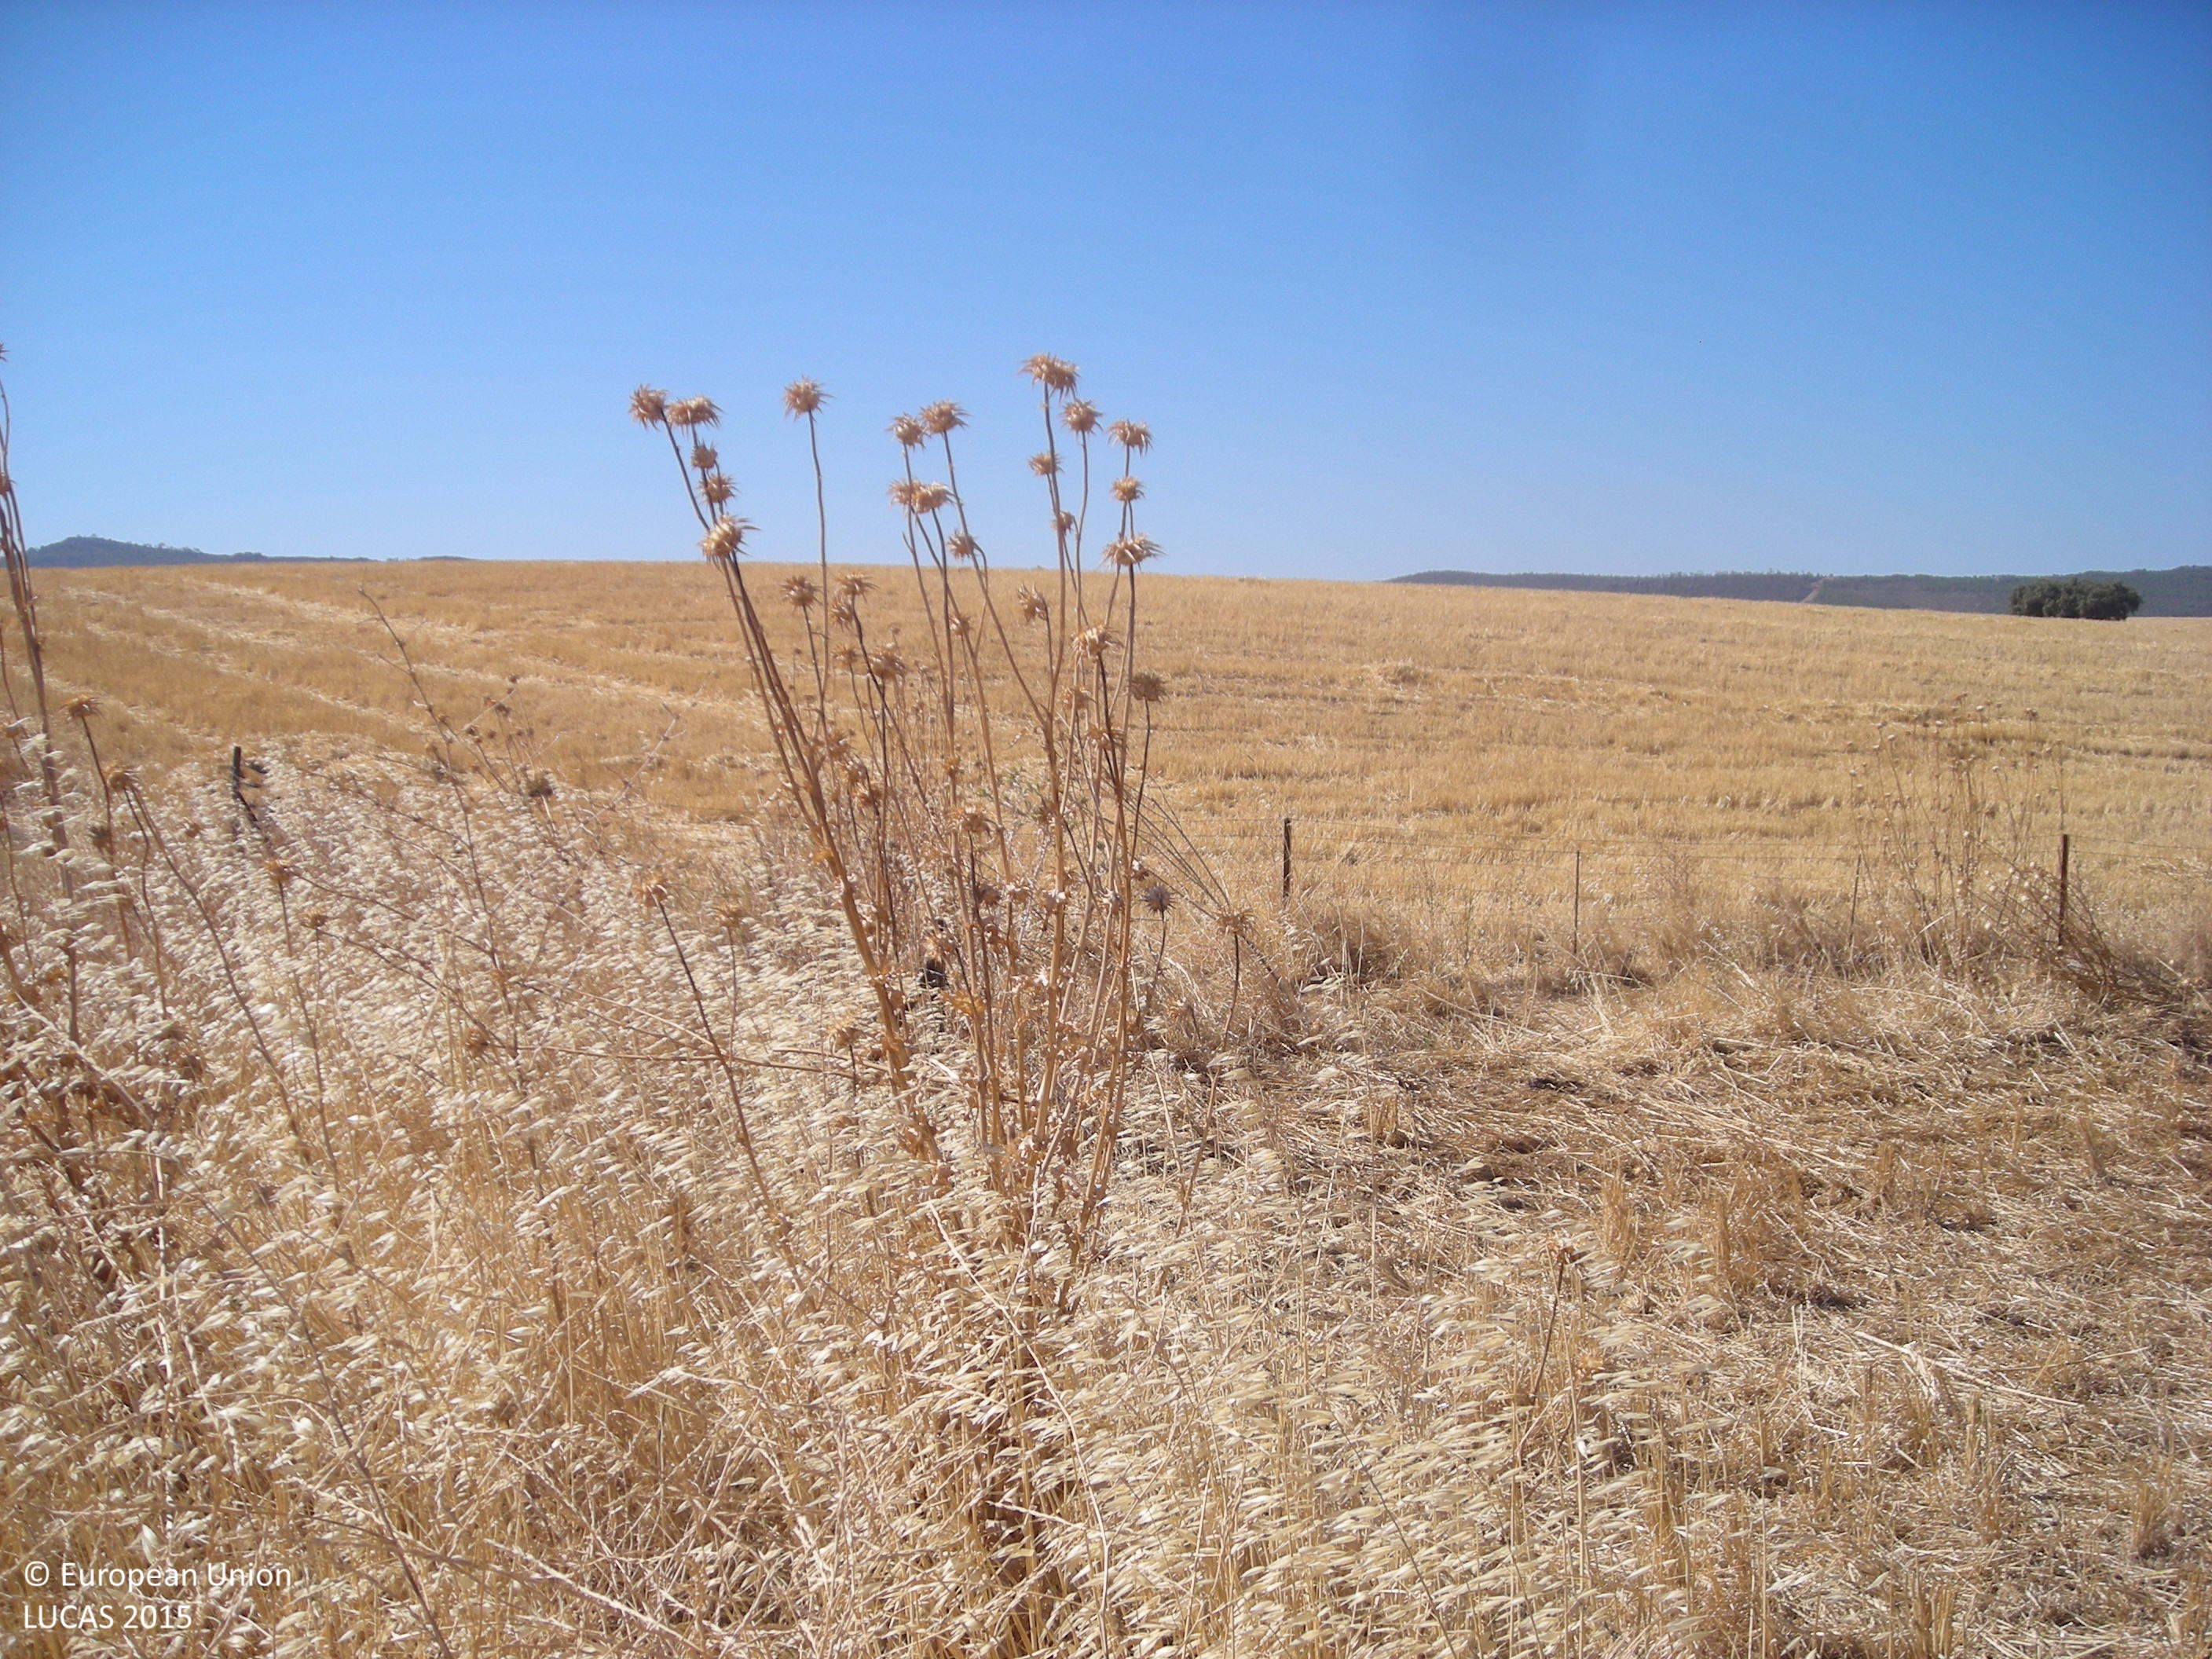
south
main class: Cropland
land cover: Oats
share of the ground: > 75 %
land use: Agriculture (excluding fallow land and kitchen gardens)
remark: Harvested field
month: July
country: ES
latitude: 38.8383
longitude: -5.8651
